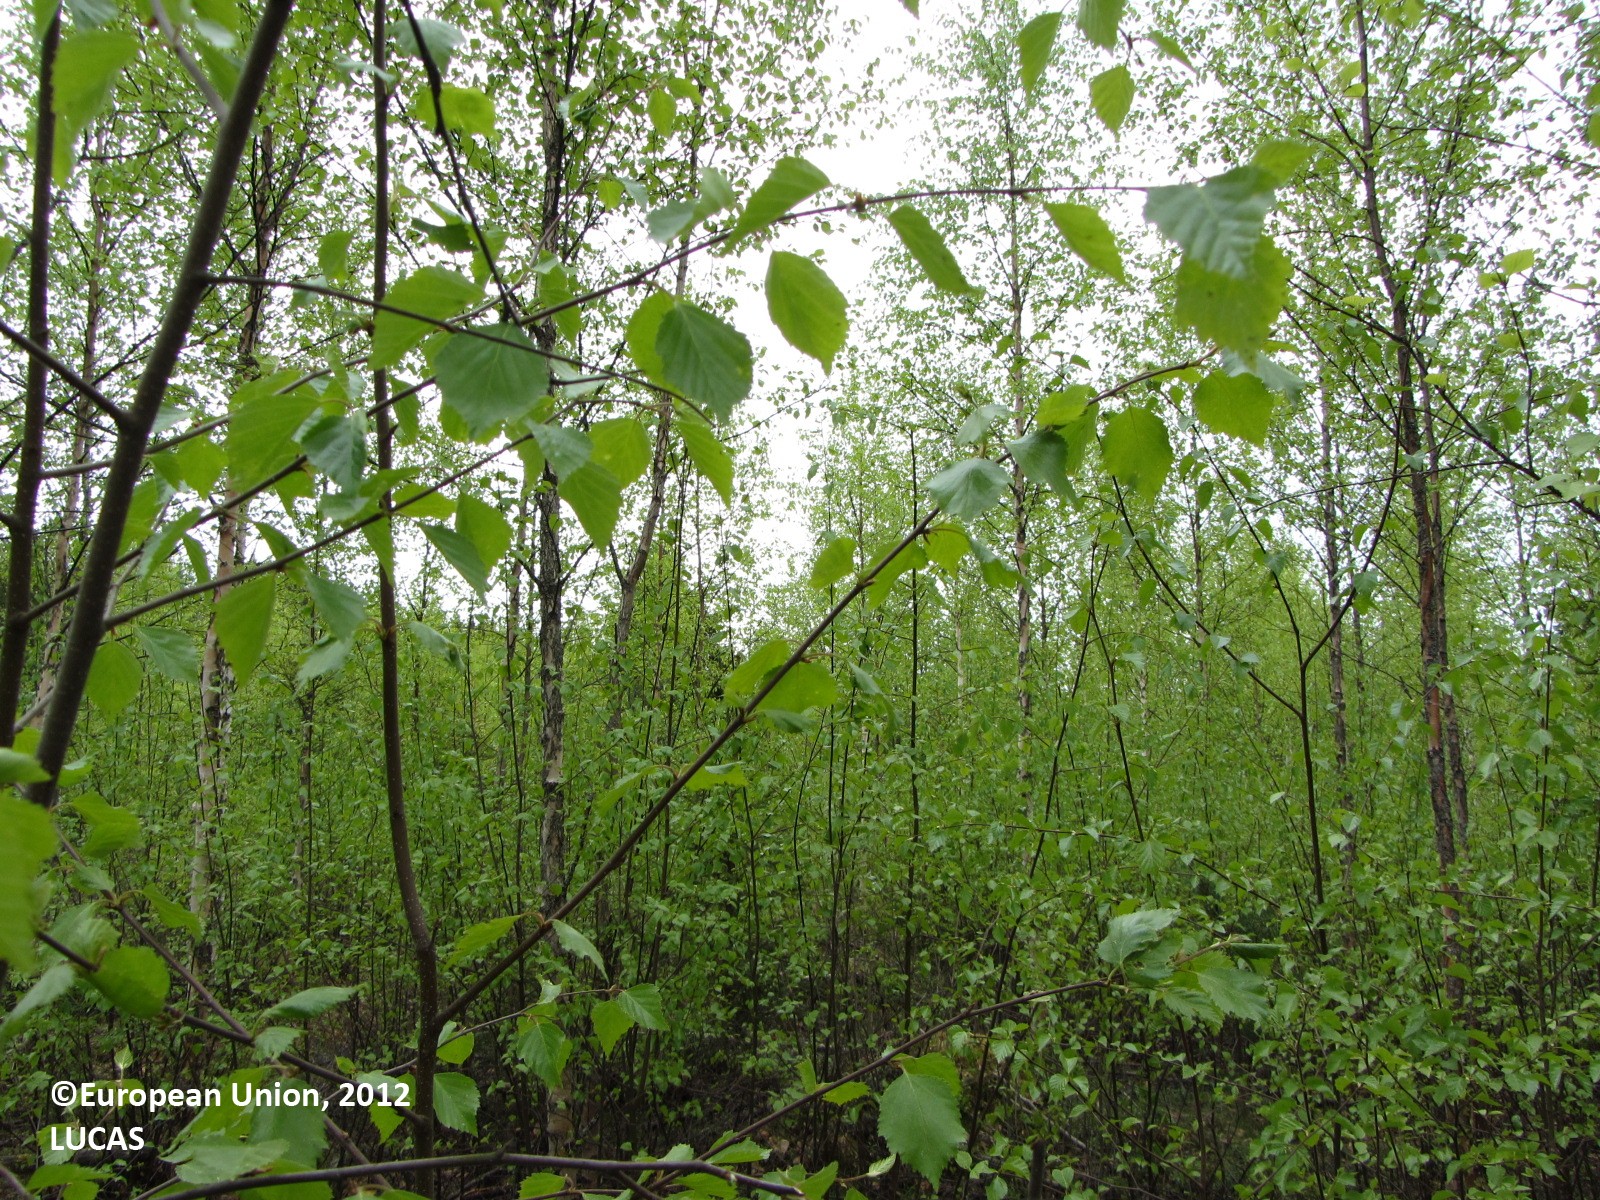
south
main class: Woodland
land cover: Broadleaved woodland
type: hemiboreal forest and nemoral coniferous forest and mixed broadleaved-coniferous forest
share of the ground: > 75 %
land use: Forestry
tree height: > 5 m
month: May
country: FI
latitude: 62.4092
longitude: 25.3403
